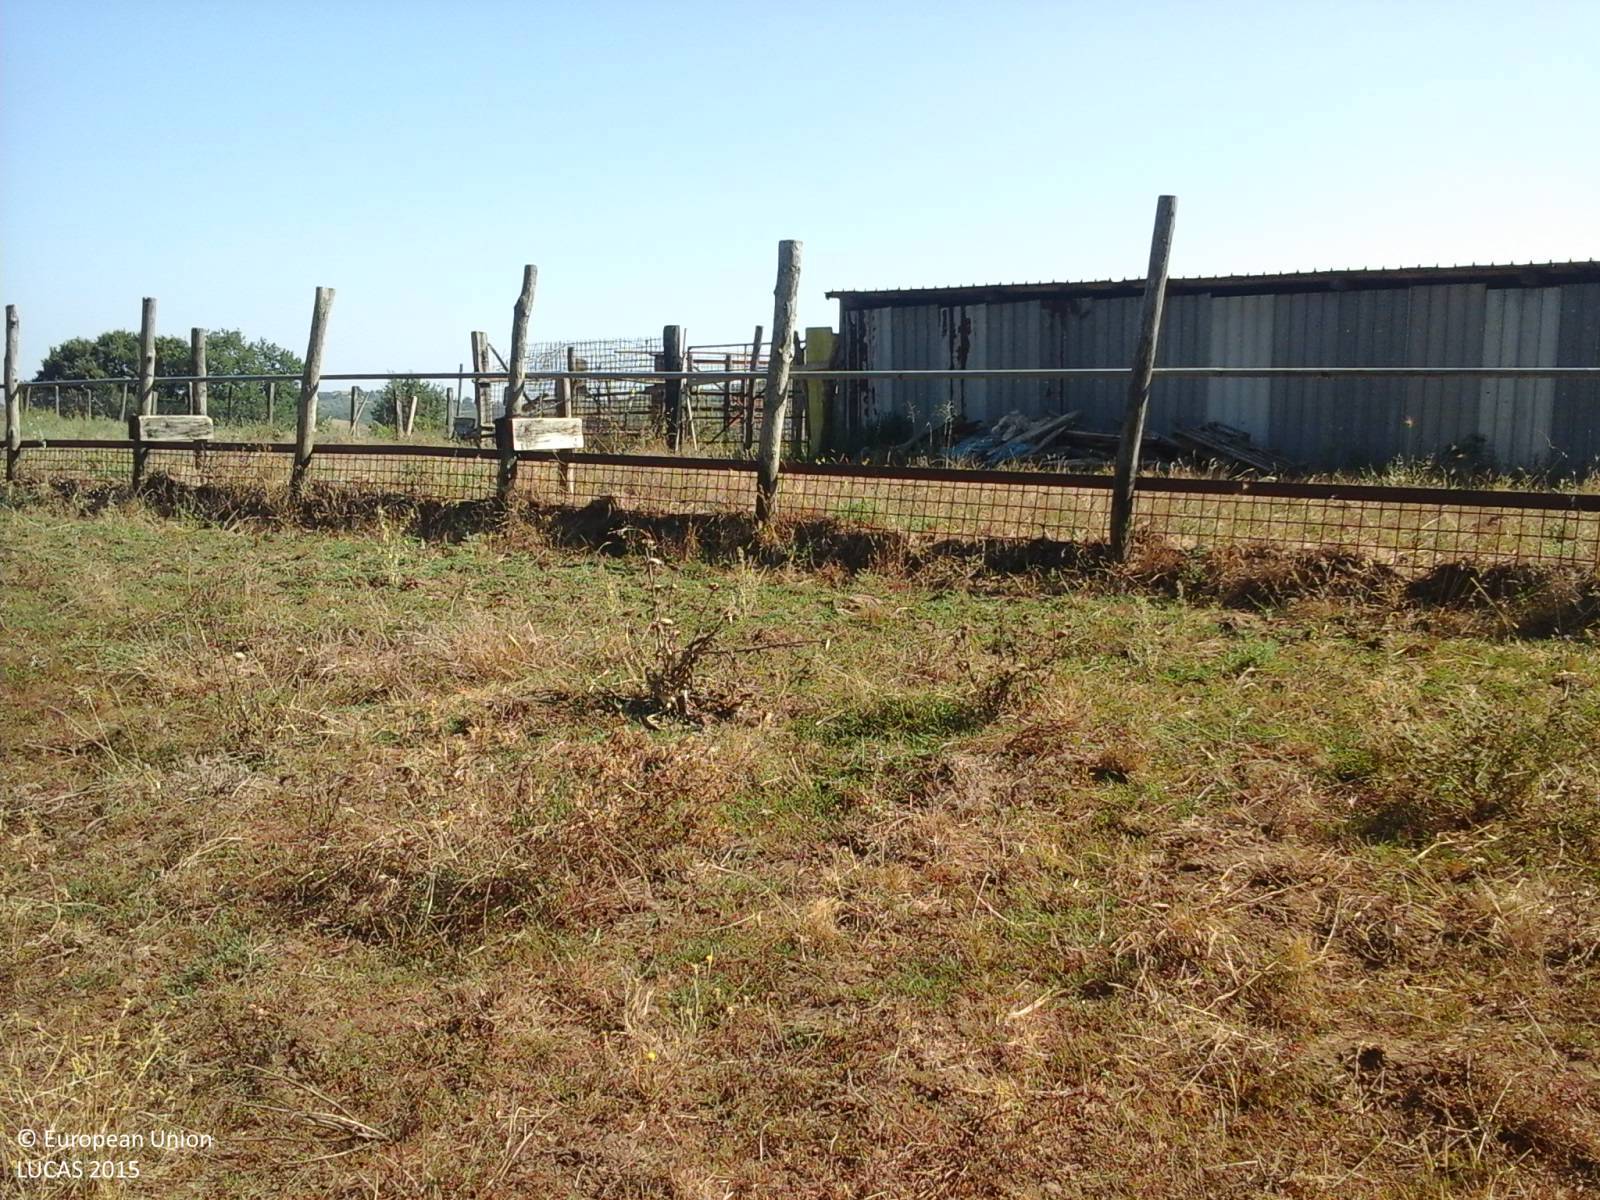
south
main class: Grassland
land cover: Grassland without tree/shrub cover
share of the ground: > 75 %
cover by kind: herbaceous plants 55 %, unconsolidated bare surface 45 %
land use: Agriculture (excluding fallow land and kitchen gardens)
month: July
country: IT
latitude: 42.1889
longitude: 12.5218
